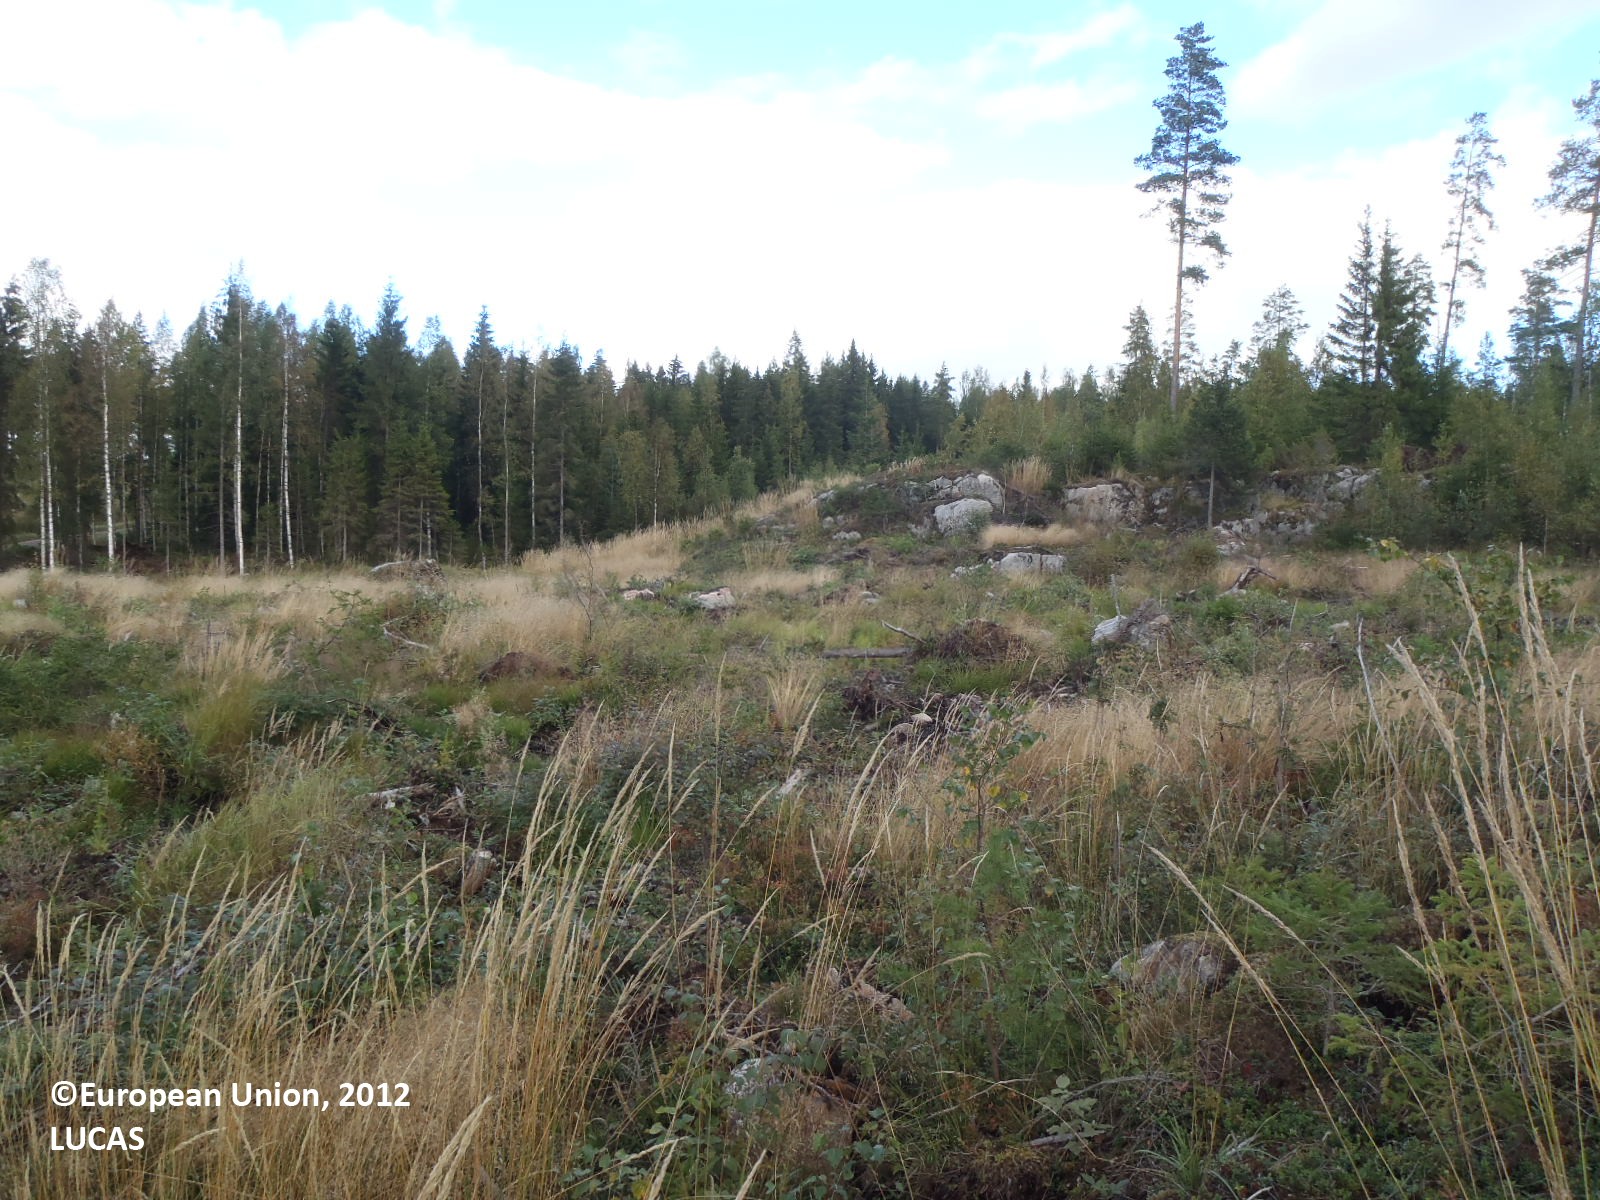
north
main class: Shrubland
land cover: Shrubland with sparse tree cover
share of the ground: > 75 %
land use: Forestry
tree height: > 5 m
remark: Clear cut
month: September
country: FI
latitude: 61.2917
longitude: 22.6264
